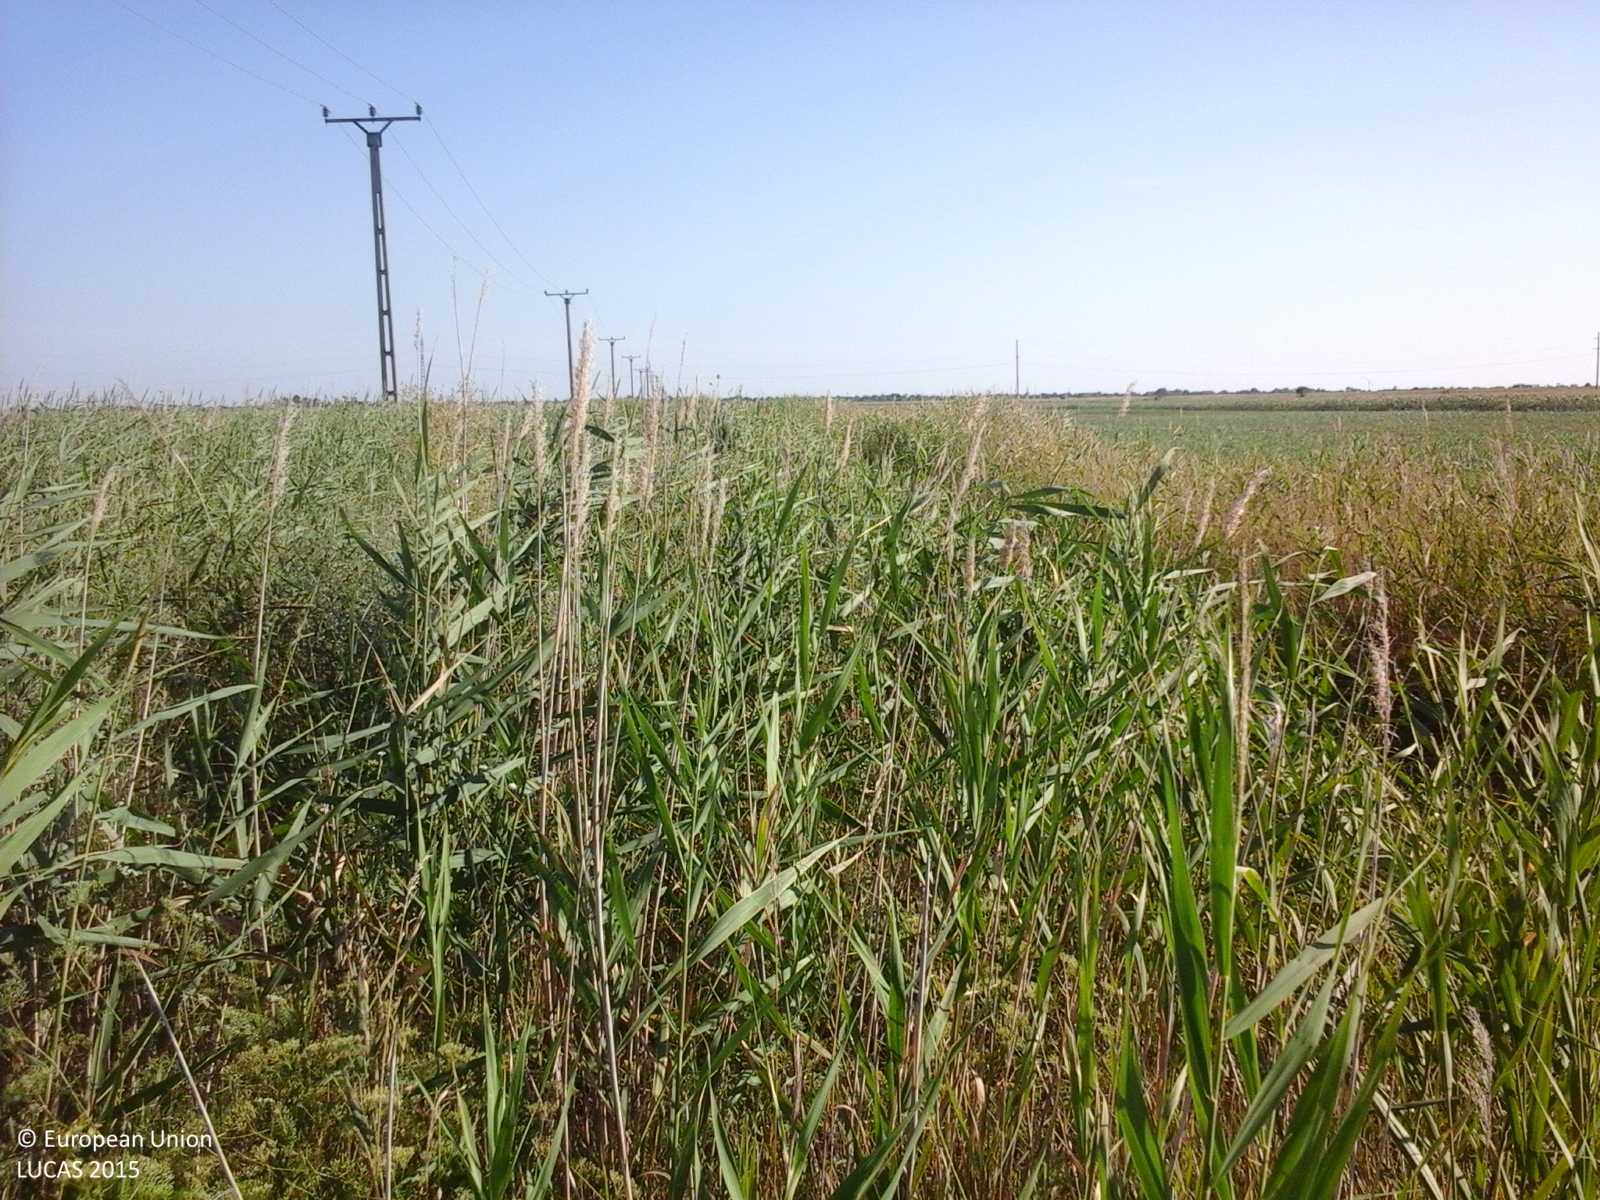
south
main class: Cropland
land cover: Temporary grasslands
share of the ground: > 75 %
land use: Agriculture (excluding fallow land and kitchen gardens)
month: August
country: RO
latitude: 45.5849
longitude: 27.4427
